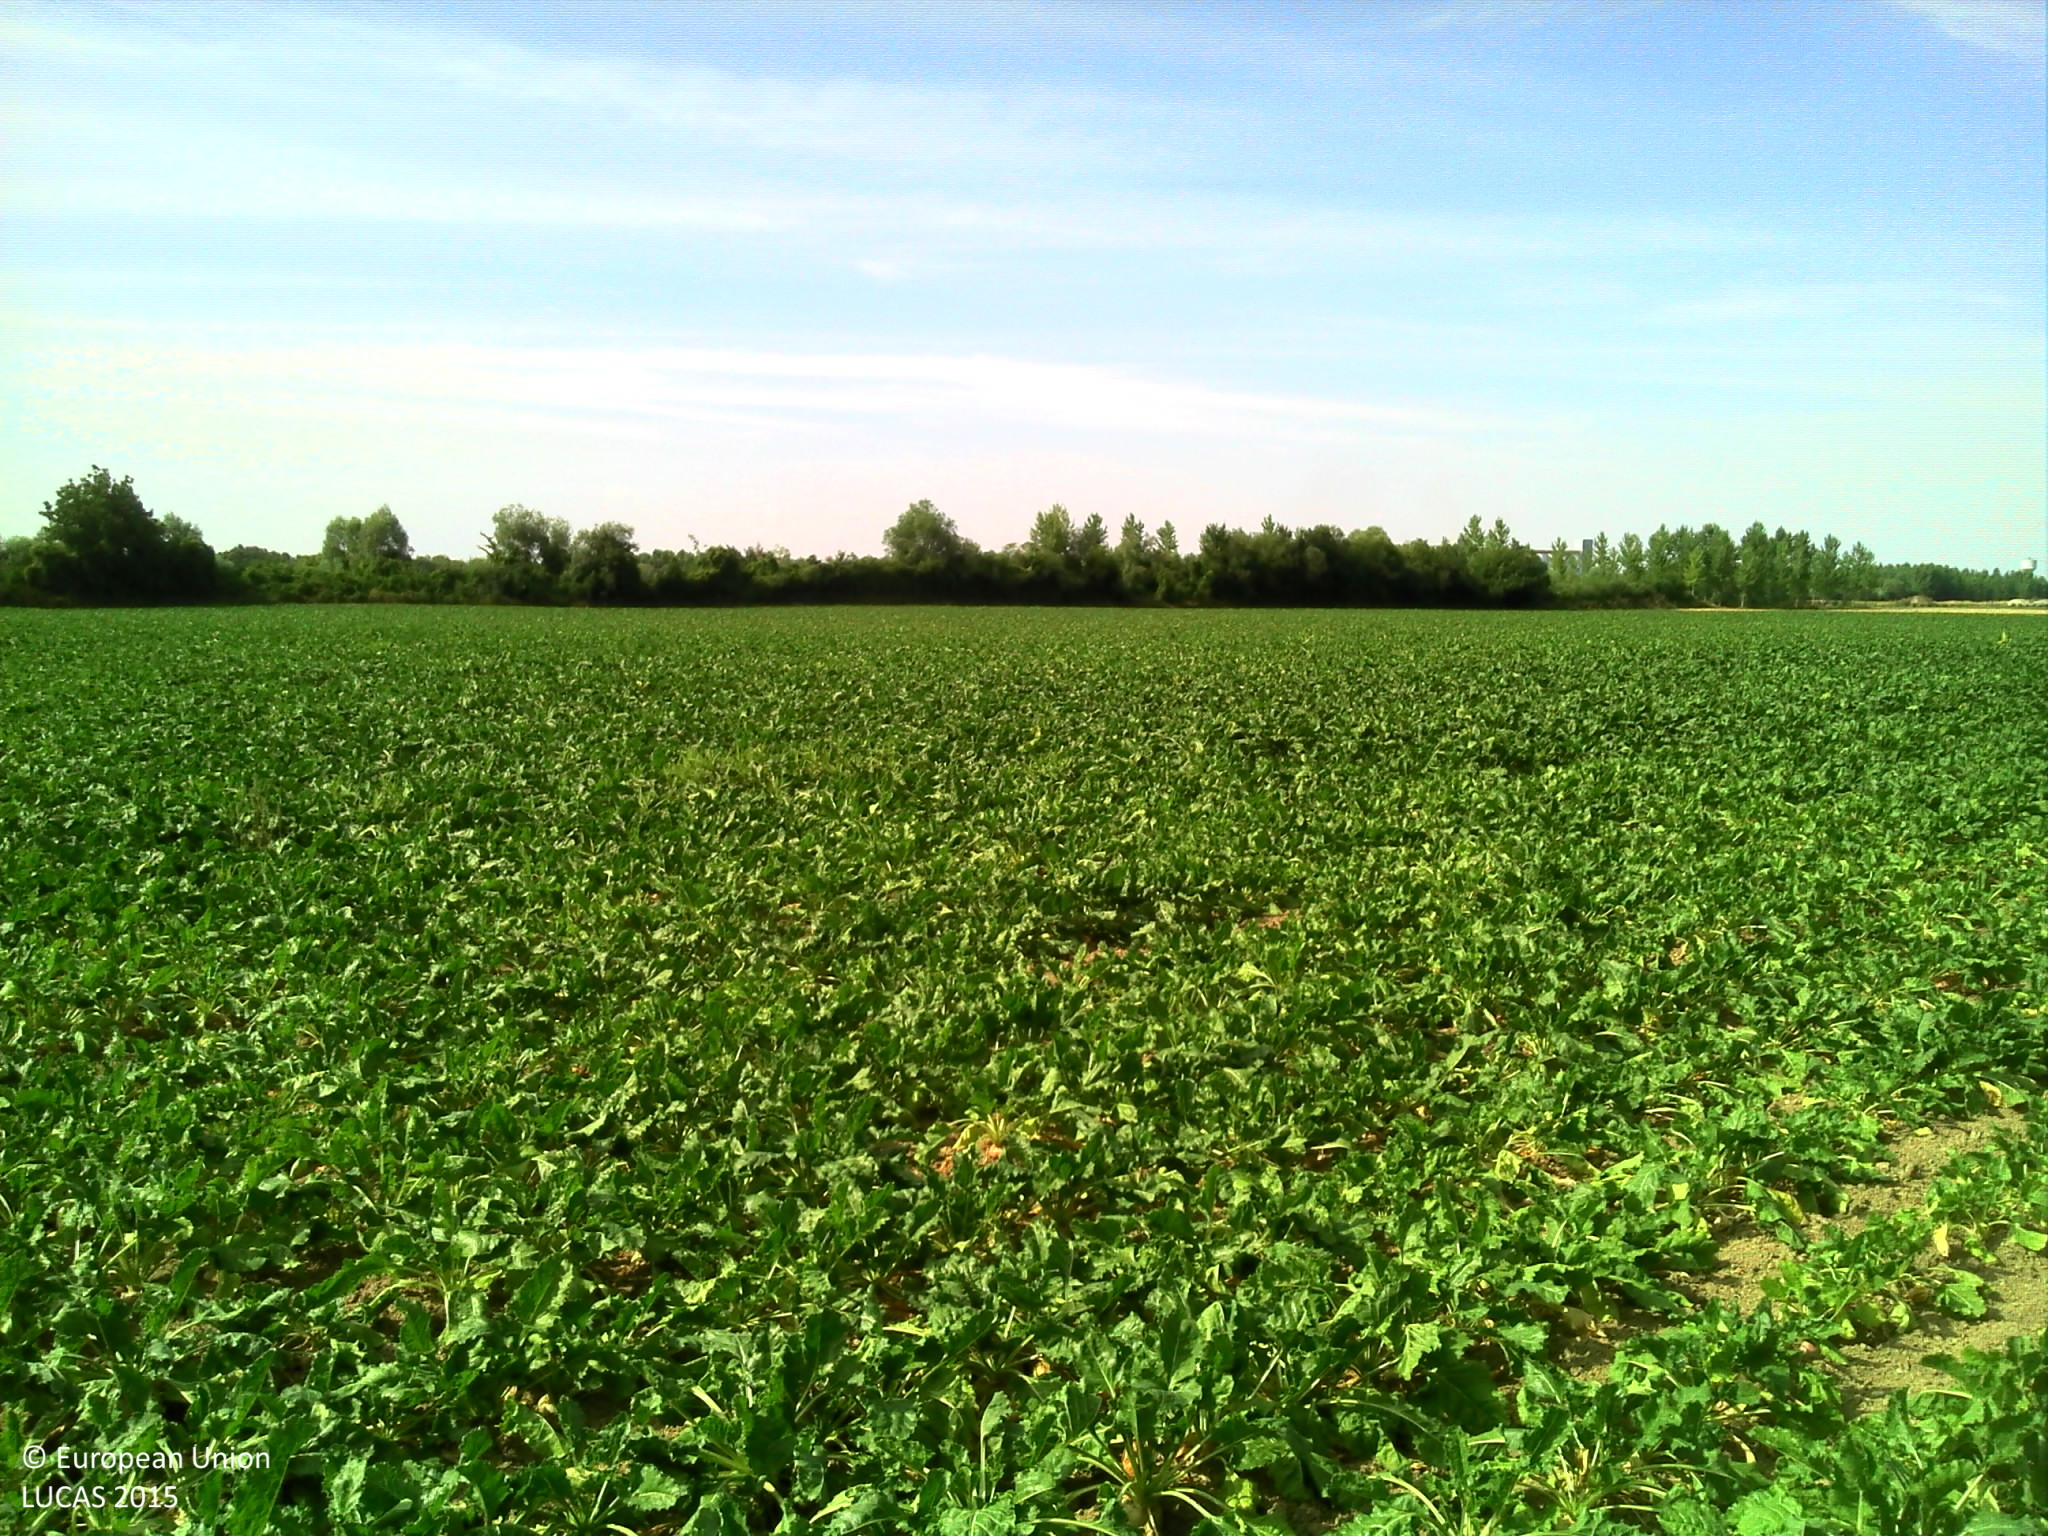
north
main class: Cropland
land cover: Sugar beet
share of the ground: > 75 %
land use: Agriculture (excluding fallow land and kitchen gardens)
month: July
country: FR
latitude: 48.5724
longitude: 3.8013
